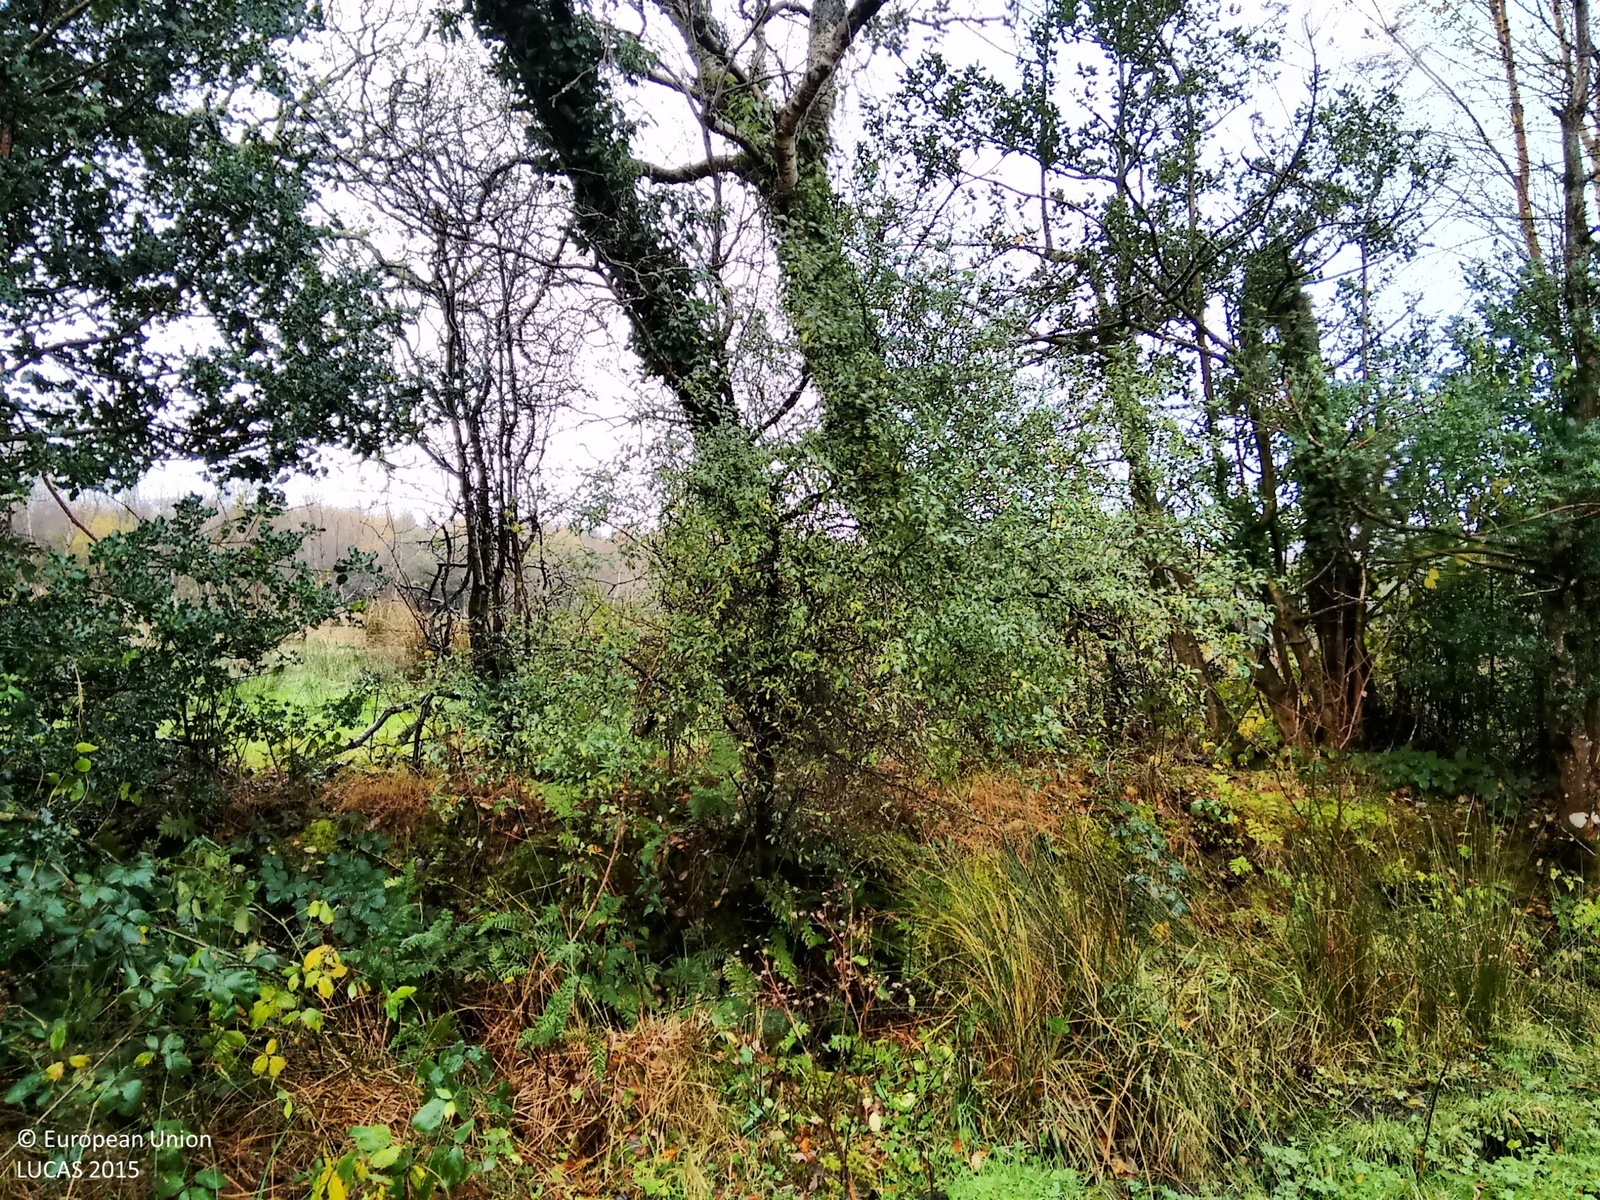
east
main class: Grassland
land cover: Grassland without tree/shrub cover
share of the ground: > 75 %
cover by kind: herbaceous plants 100 %
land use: Agriculture (excluding fallow land and kitchen gardens)
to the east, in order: Grassland without tree/shrub cover; Ditches and canals; Fences; Abandoned hedges; Grassland without tree/shrub cover; Fences; Abandoned hedges; Ditches and canals; Grassland without tree/shrub cover; Fences; Broadleaved woodland; Grassland without tree/shrub cover; Ditches and canals; Grassland without tree/shrub cover; Broadleaved woodland
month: November
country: IE
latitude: 54.3693
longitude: -8.0773
